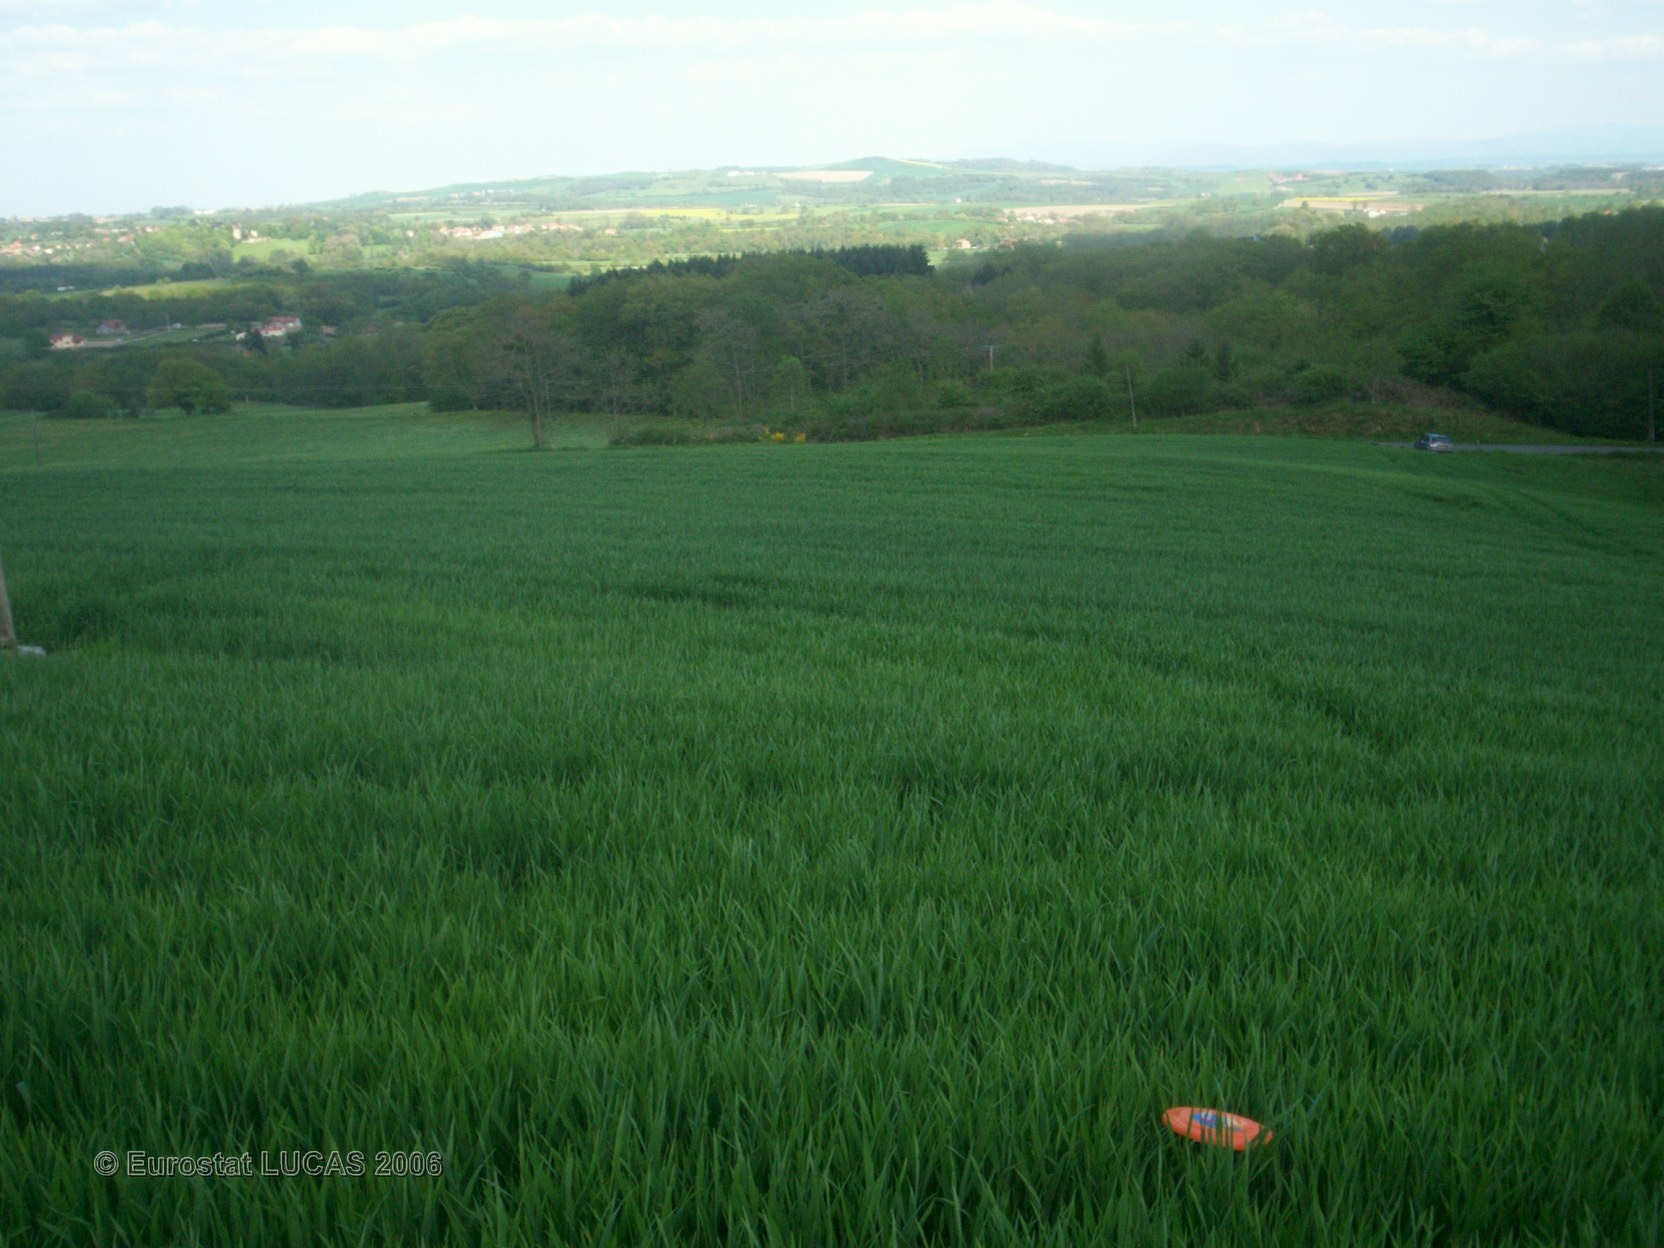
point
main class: Cropland
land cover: Common wheat
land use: Agriculture (excluding fallow land and kitchen gardens)
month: May
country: FR
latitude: 46.0174
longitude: 3.0627
